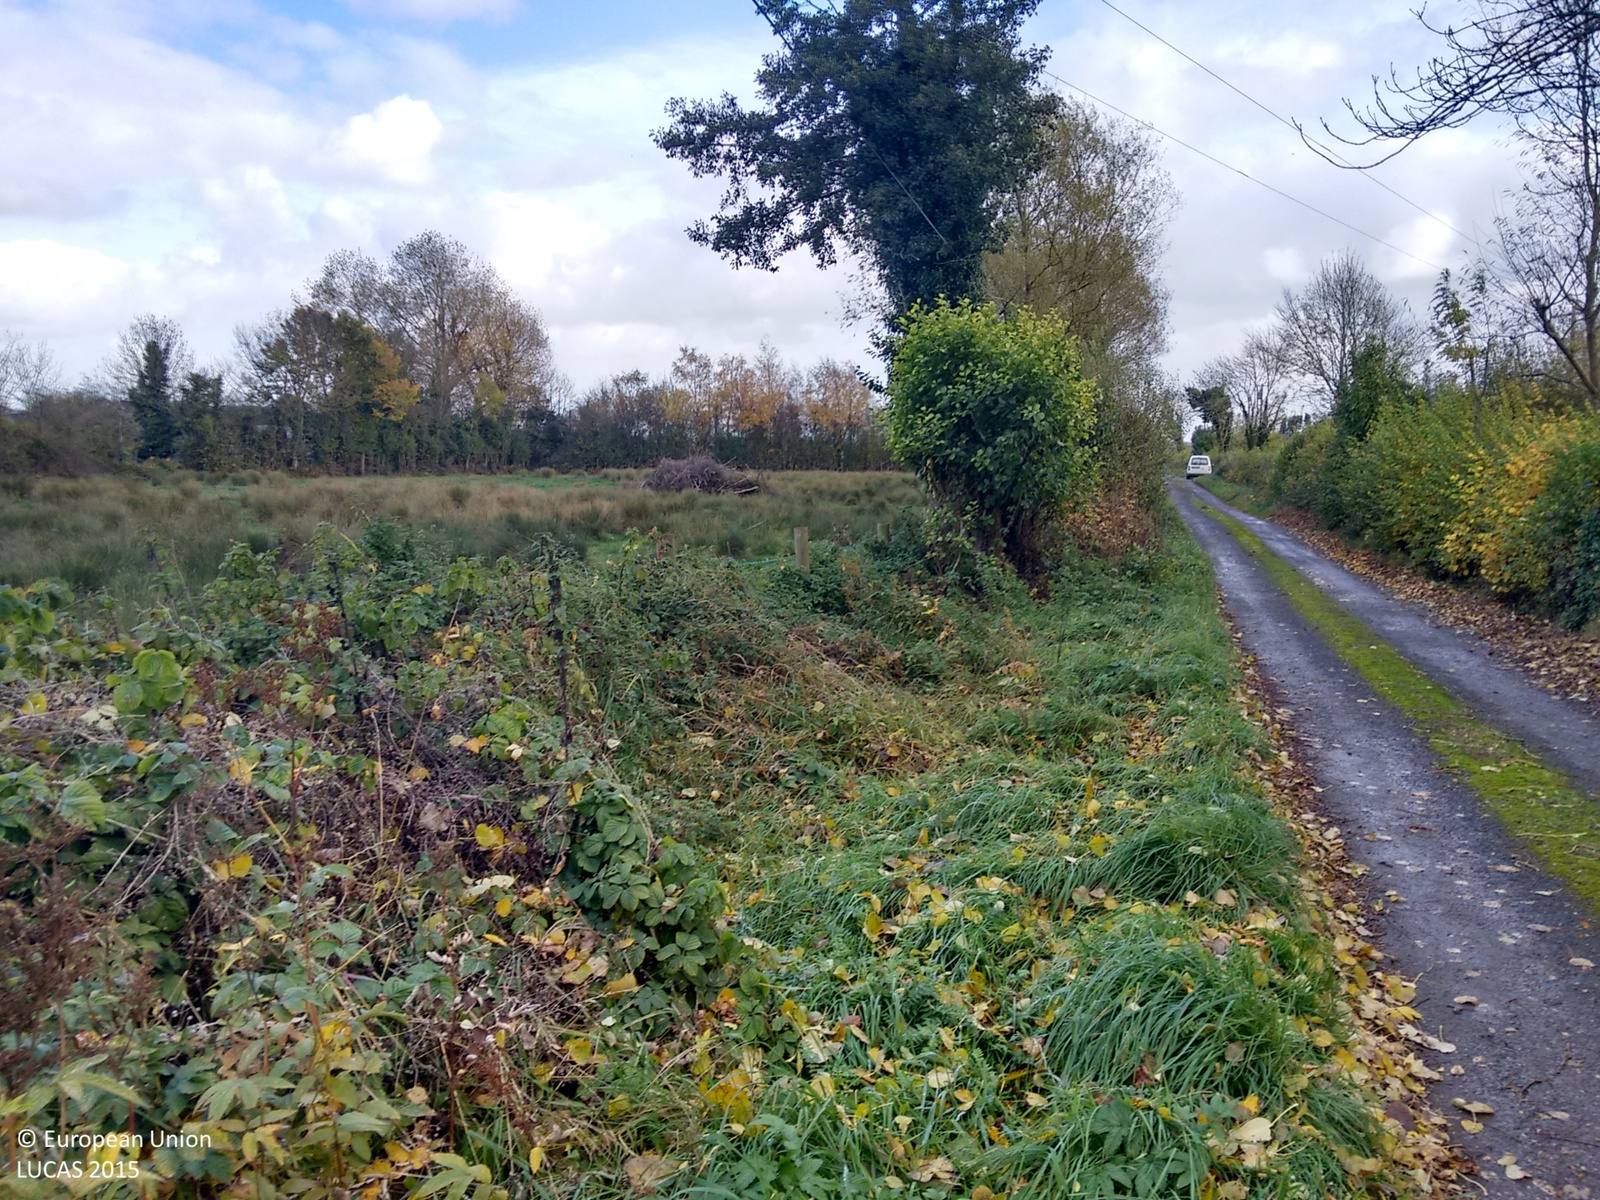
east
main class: Grassland
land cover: Grassland without tree/shrub cover
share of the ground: > 75 %
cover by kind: herbaceous plants 70 %, shrubs 5 %, consolidated bare surface 5 %
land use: Agriculture (excluding fallow land and kitchen gardens)
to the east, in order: Grassland without tree/shrub cover; Fences; Managed hedges; Paved roads, cycling and walking lanes; Managed hedges; Electric lines; Grassland without tree/shrub cover; Electric lines; Grassland without tree/shrub cover
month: October
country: IE
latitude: 53.1814
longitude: -7.7488
